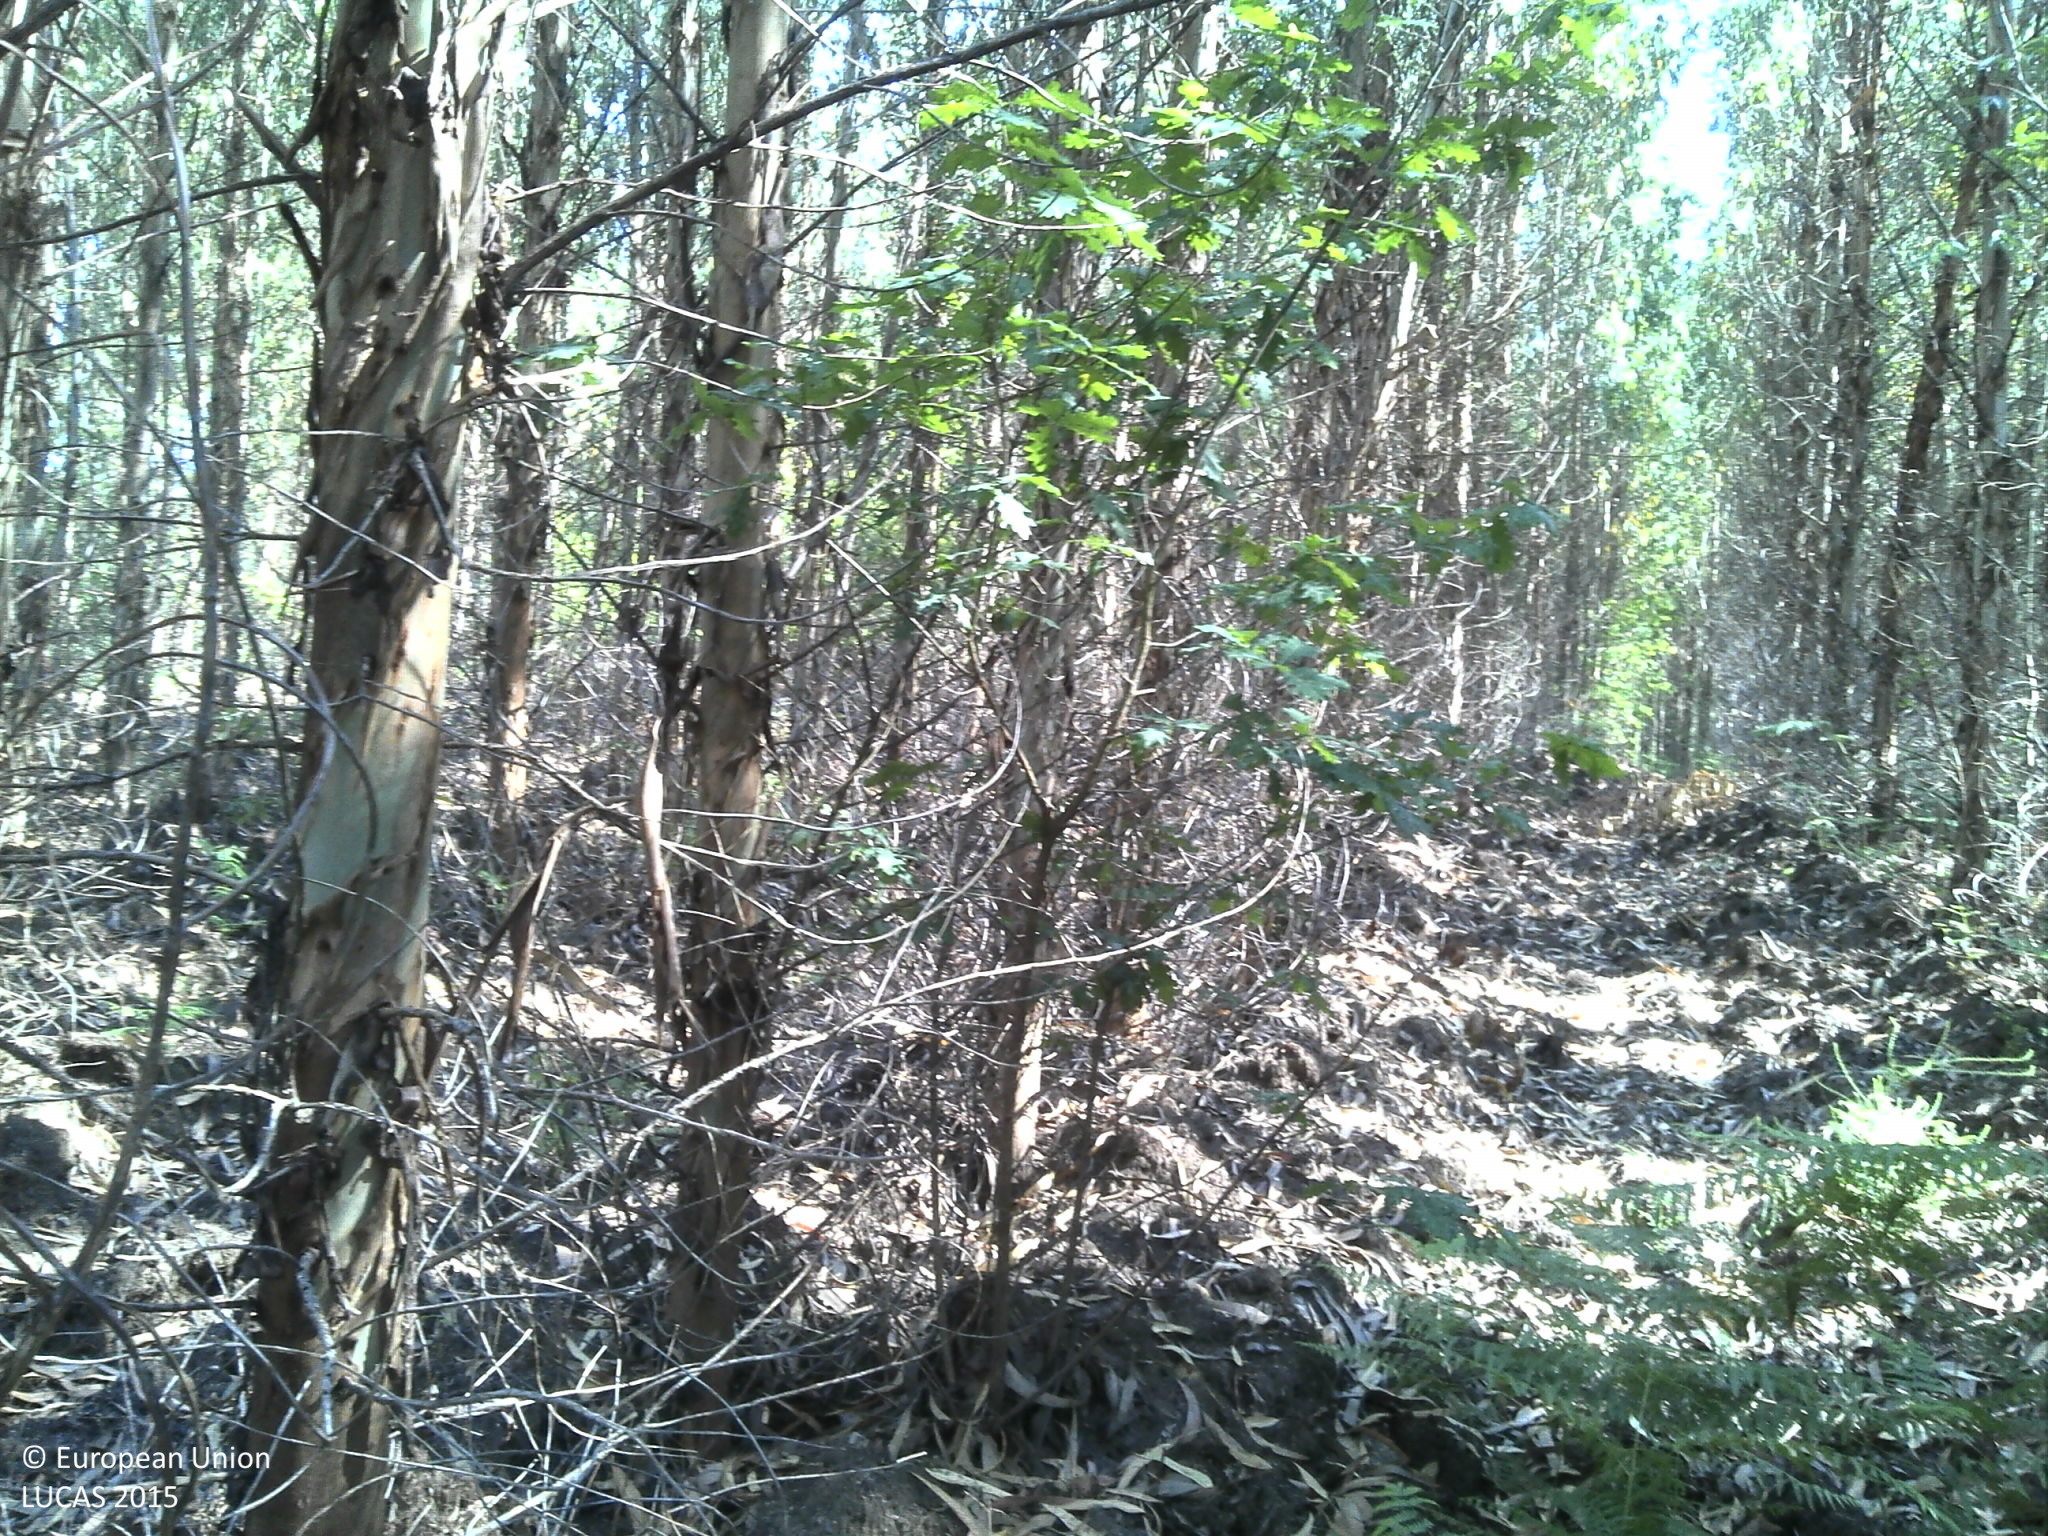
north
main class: Woodland
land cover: Broadleaved woodland
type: exotic forest
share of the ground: > 75 %
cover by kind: broadleaved forest trees 75 %, unconsolidated bare surface 20 %, shrubs 5 %
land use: Forestry
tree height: > 5 m
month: June
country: PT
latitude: 40.5871
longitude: -8.0746
